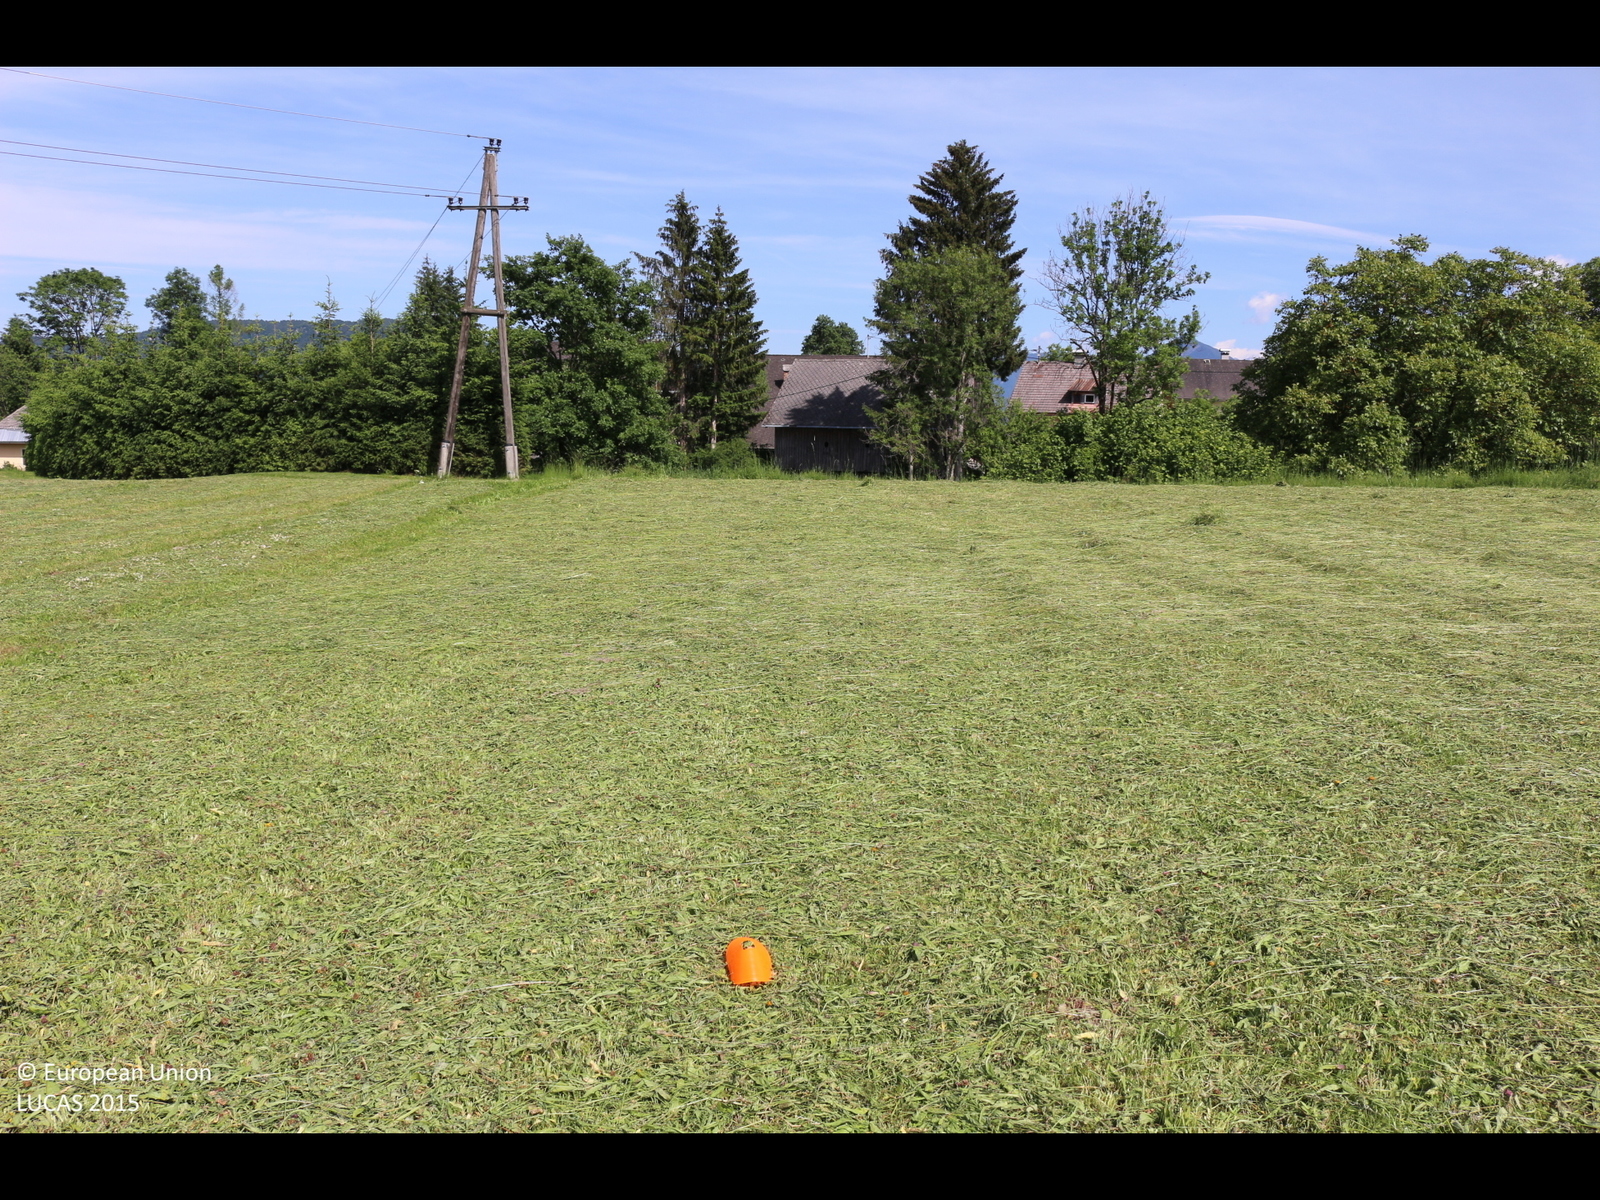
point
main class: Grassland
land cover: Grassland without tree/shrub cover
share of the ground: > 75 %
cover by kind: herbaceous plants 100 %
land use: Agriculture (excluding fallow land and kitchen gardens)
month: May
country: AT
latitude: 46.5639
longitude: 14.0283
